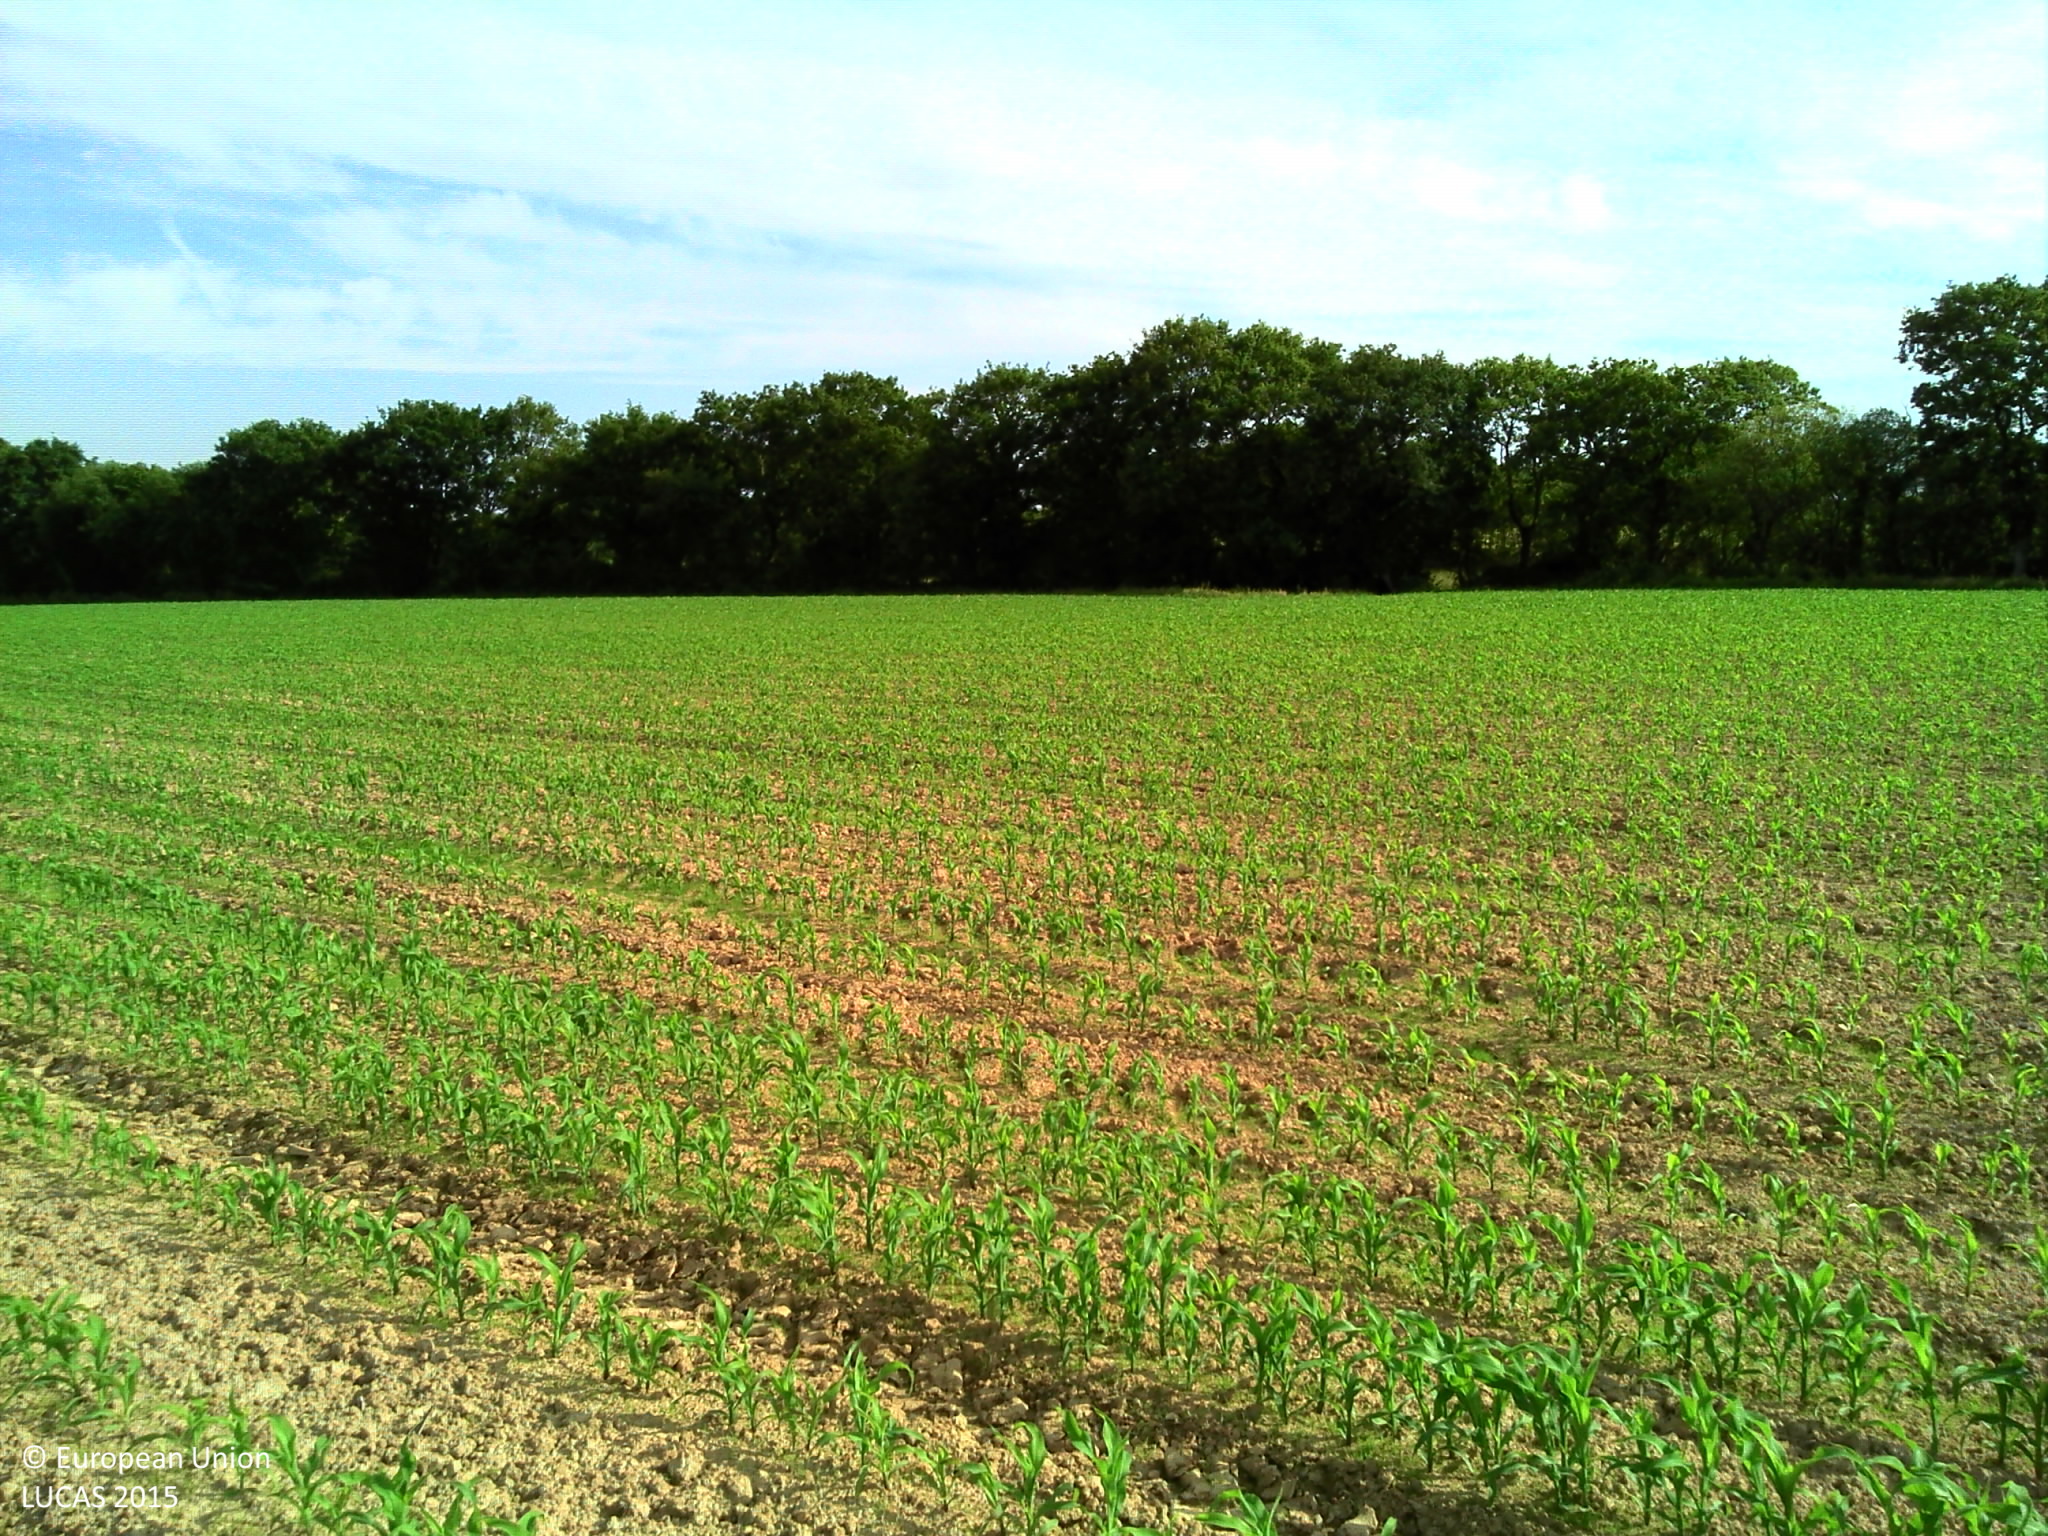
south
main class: Cropland
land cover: Maize
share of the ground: 10 - 25 %
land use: Agriculture (excluding fallow land and kitchen gardens)
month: June
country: FR
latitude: 49.2378
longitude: -1.4897
